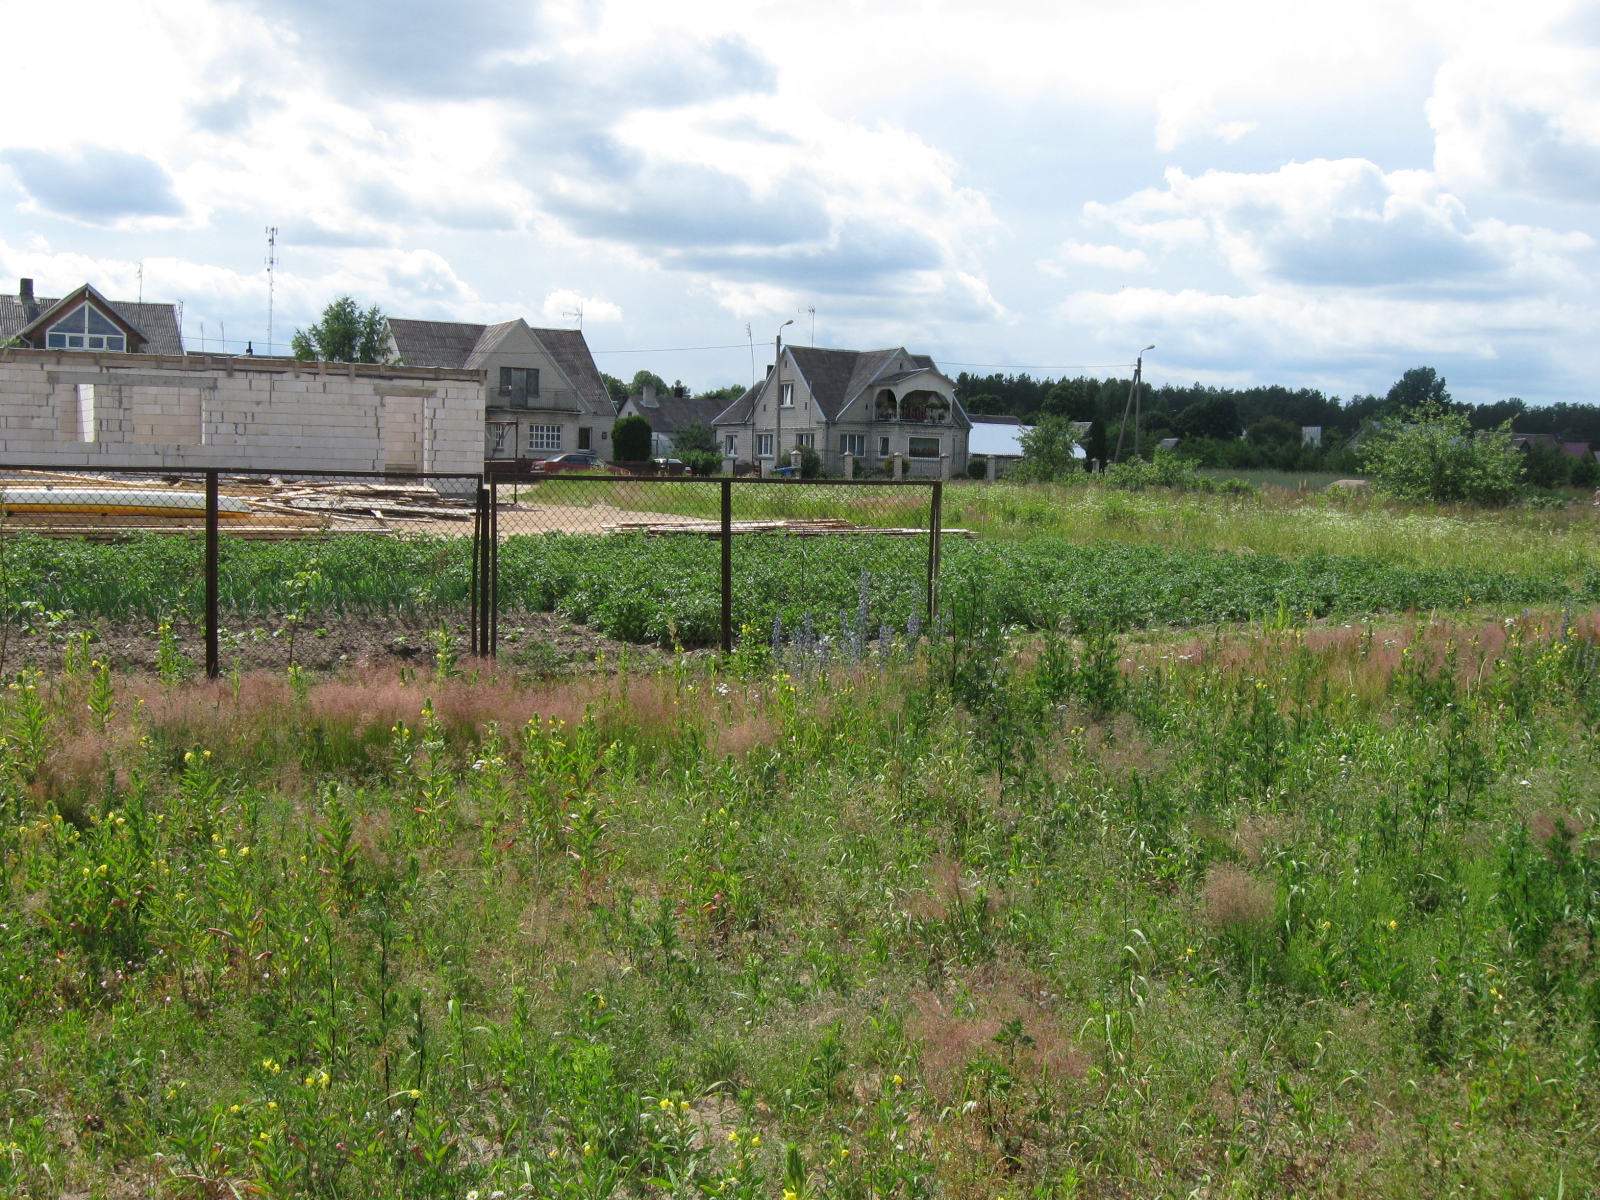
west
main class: Grassland
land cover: Spontaneously vegetated surfaces
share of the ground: > 75 %
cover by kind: herbaceous plants 75 %, unconsolidated bare surface 25 %
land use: Fallow land
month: June
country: LT
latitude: 54.2543
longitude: 24.5484
